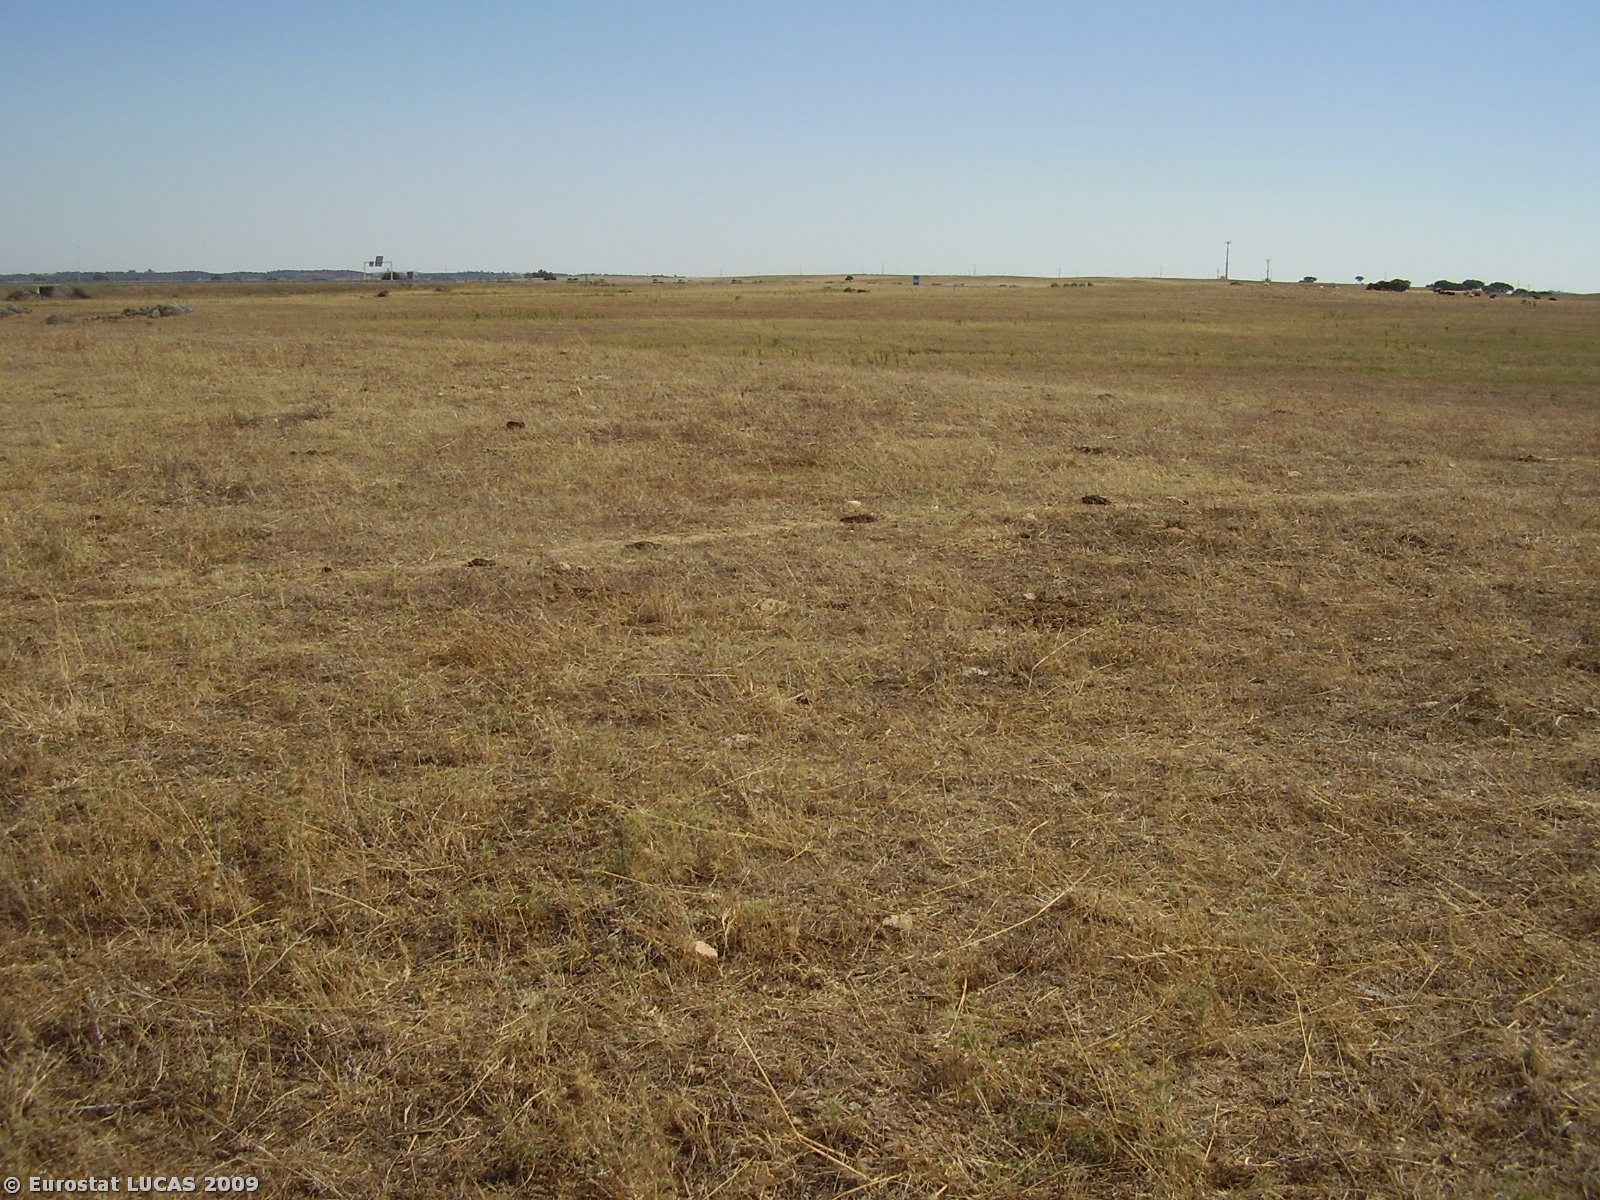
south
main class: Grassland
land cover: Grassland without tree/shrub cover
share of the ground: > 75 %
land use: Fallow land
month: July
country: PT
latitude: 38.6502
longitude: -7.8613
